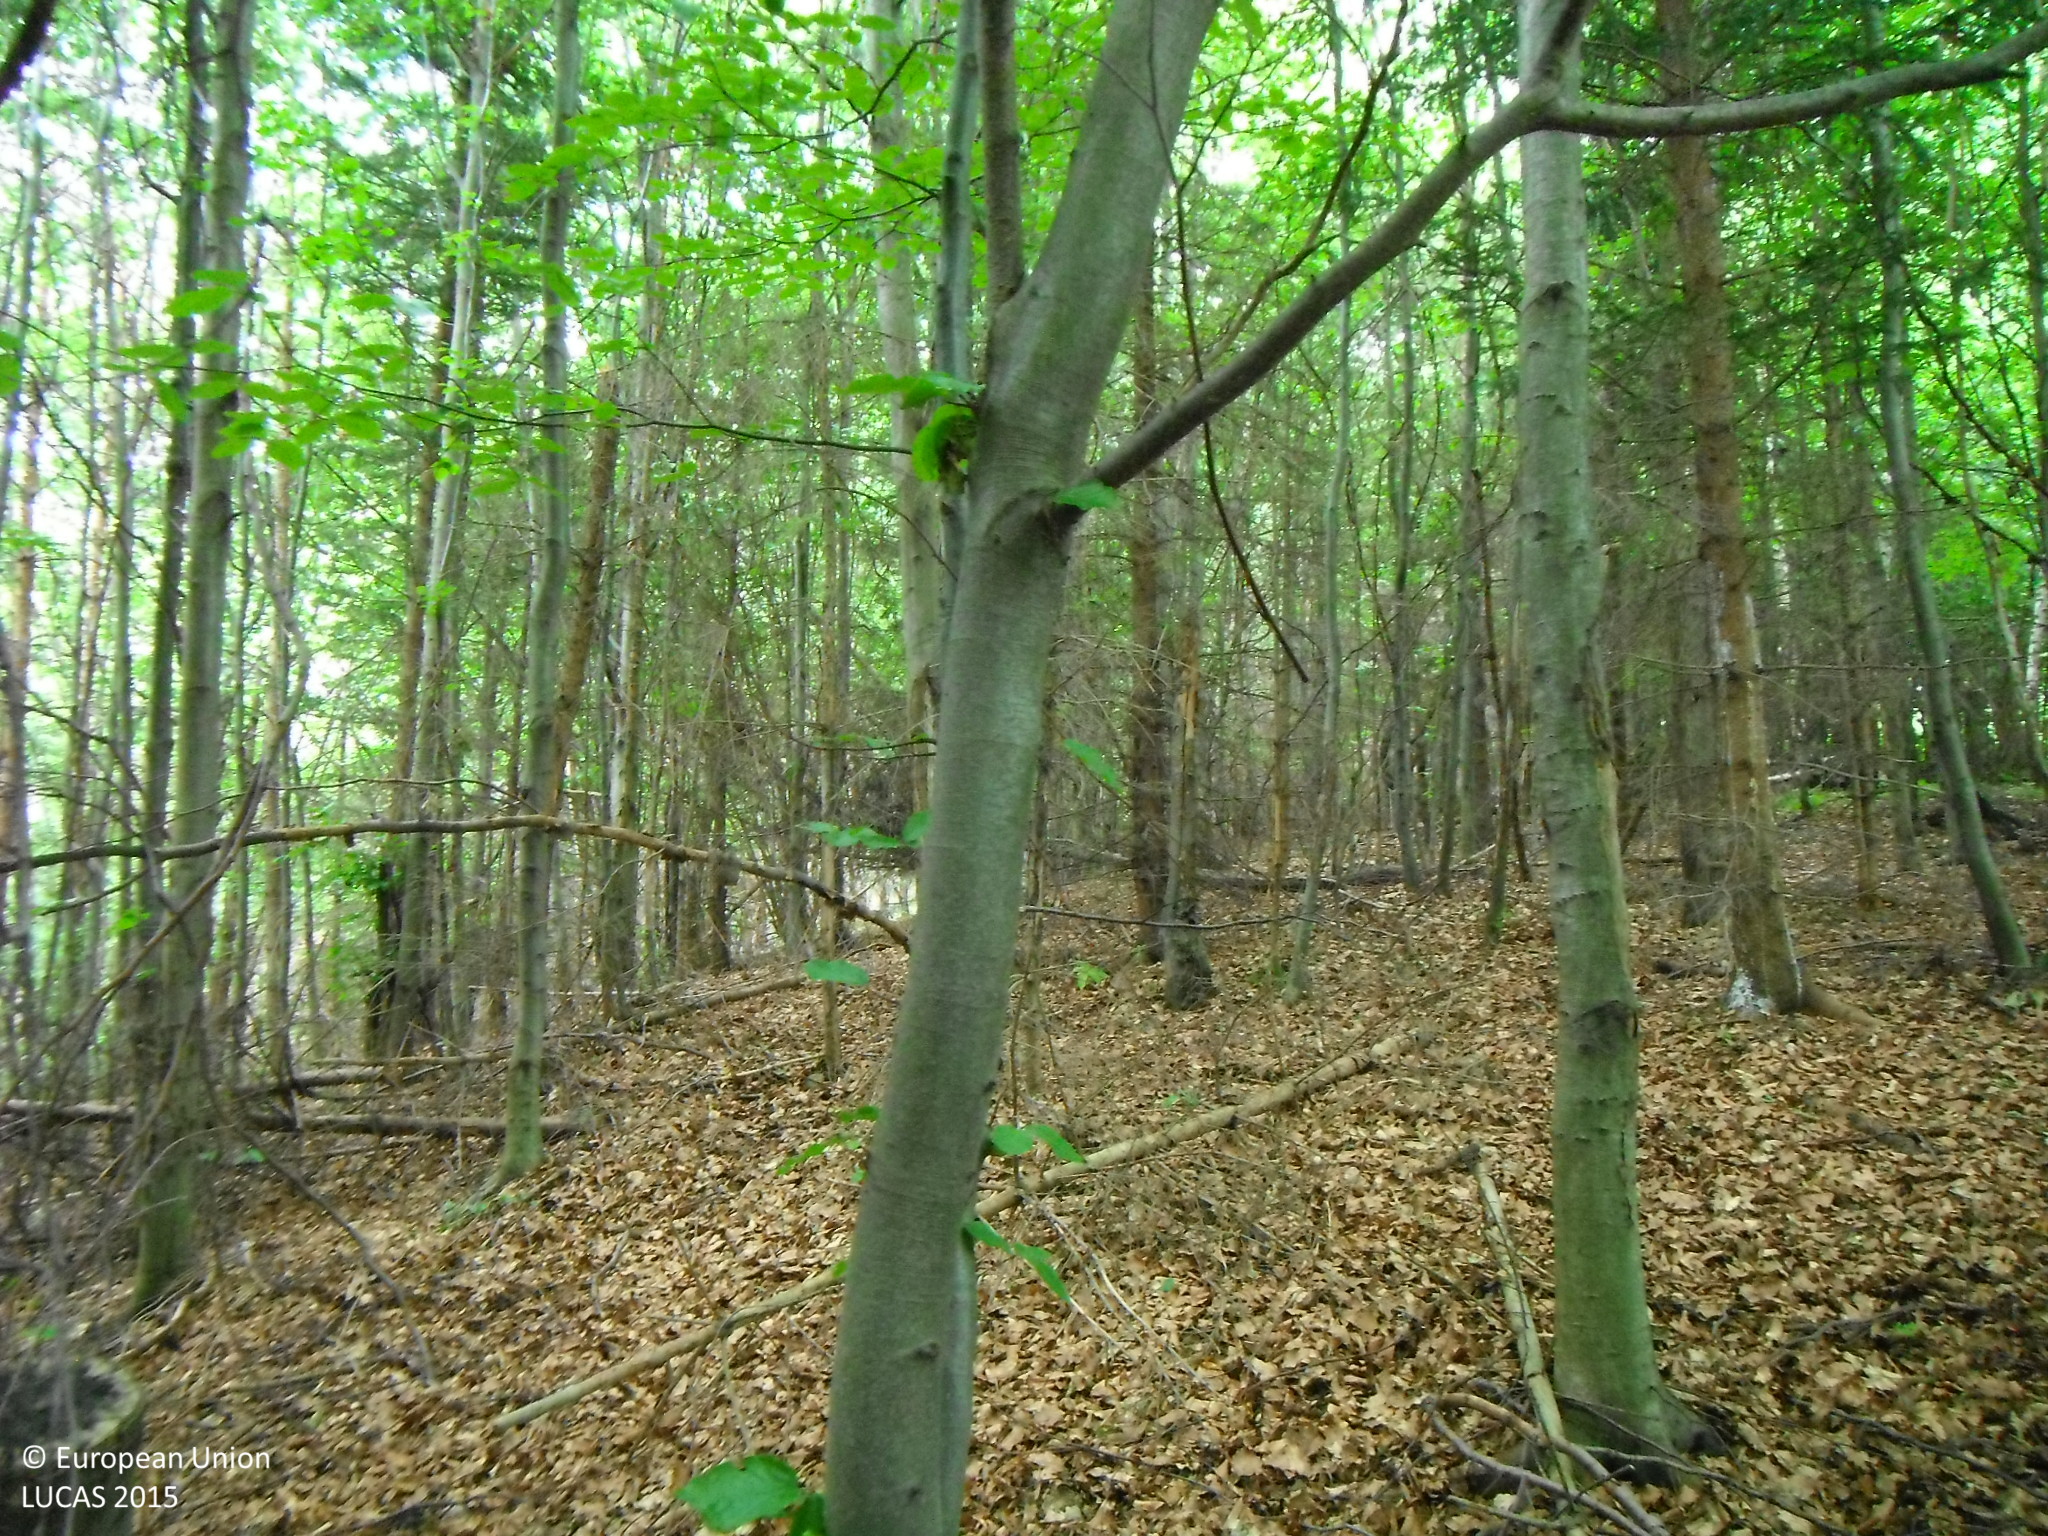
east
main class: Woodland
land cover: Spruce dominated coniferous woodland
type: alpine coniferous forest
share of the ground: > 75 %
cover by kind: coniferous forest trees 80 %, broadleaved forest trees 20 %
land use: Forestry
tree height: > 5 m
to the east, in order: Spruce dominated coniferous woodland; Tracks; Other mixed woodland; Broadleaved woodland
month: July
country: SK
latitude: 49.2570
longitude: 20.9374
